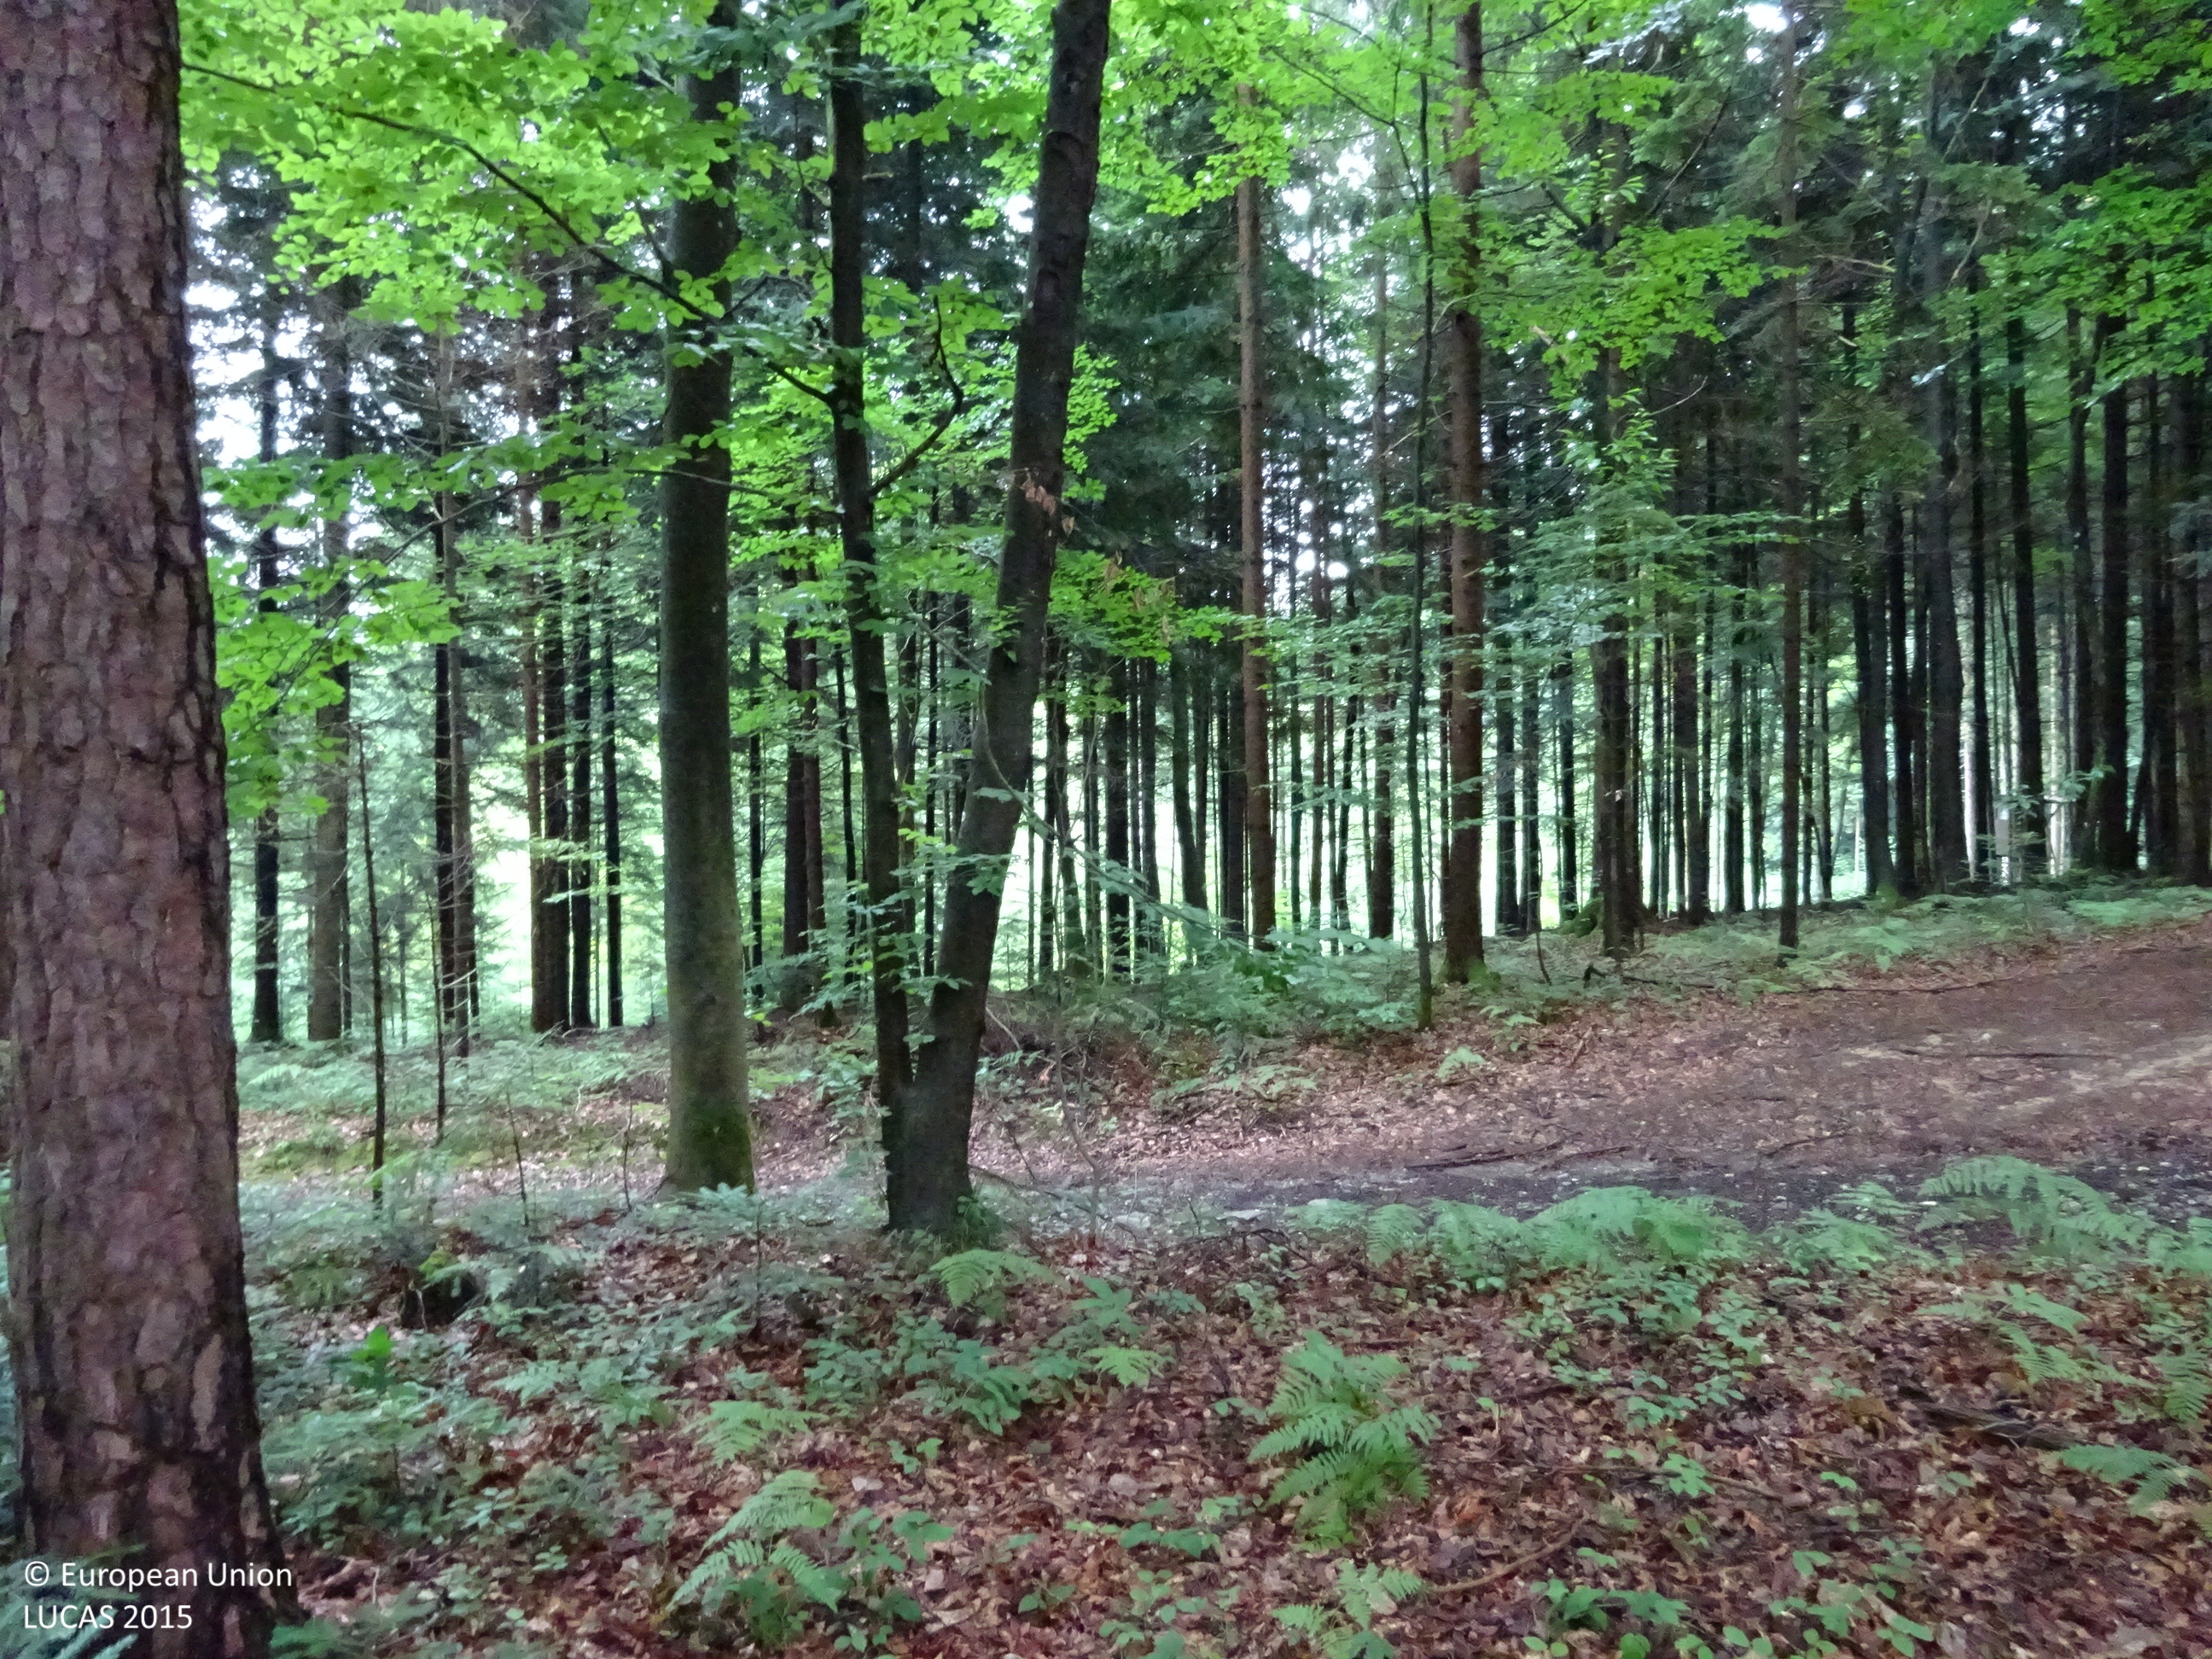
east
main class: Woodland
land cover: Pine dominated mixed woodland
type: mountainous beech forest
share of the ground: > 75 %
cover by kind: broadleaved forest trees 70 %, coniferous forest trees 30 %
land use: Forestry
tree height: > 5 m
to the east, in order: Pine dominated mixed woodland; Tracks; Spruce dominated coniferous woodland; Spruce dominated mixed woodland; Rivers and streams; Spruce dominated mixed woodland; Pine dominated mixed woodland; Other mixed woodland
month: June
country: AT
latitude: 46.7099
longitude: 15.2440
